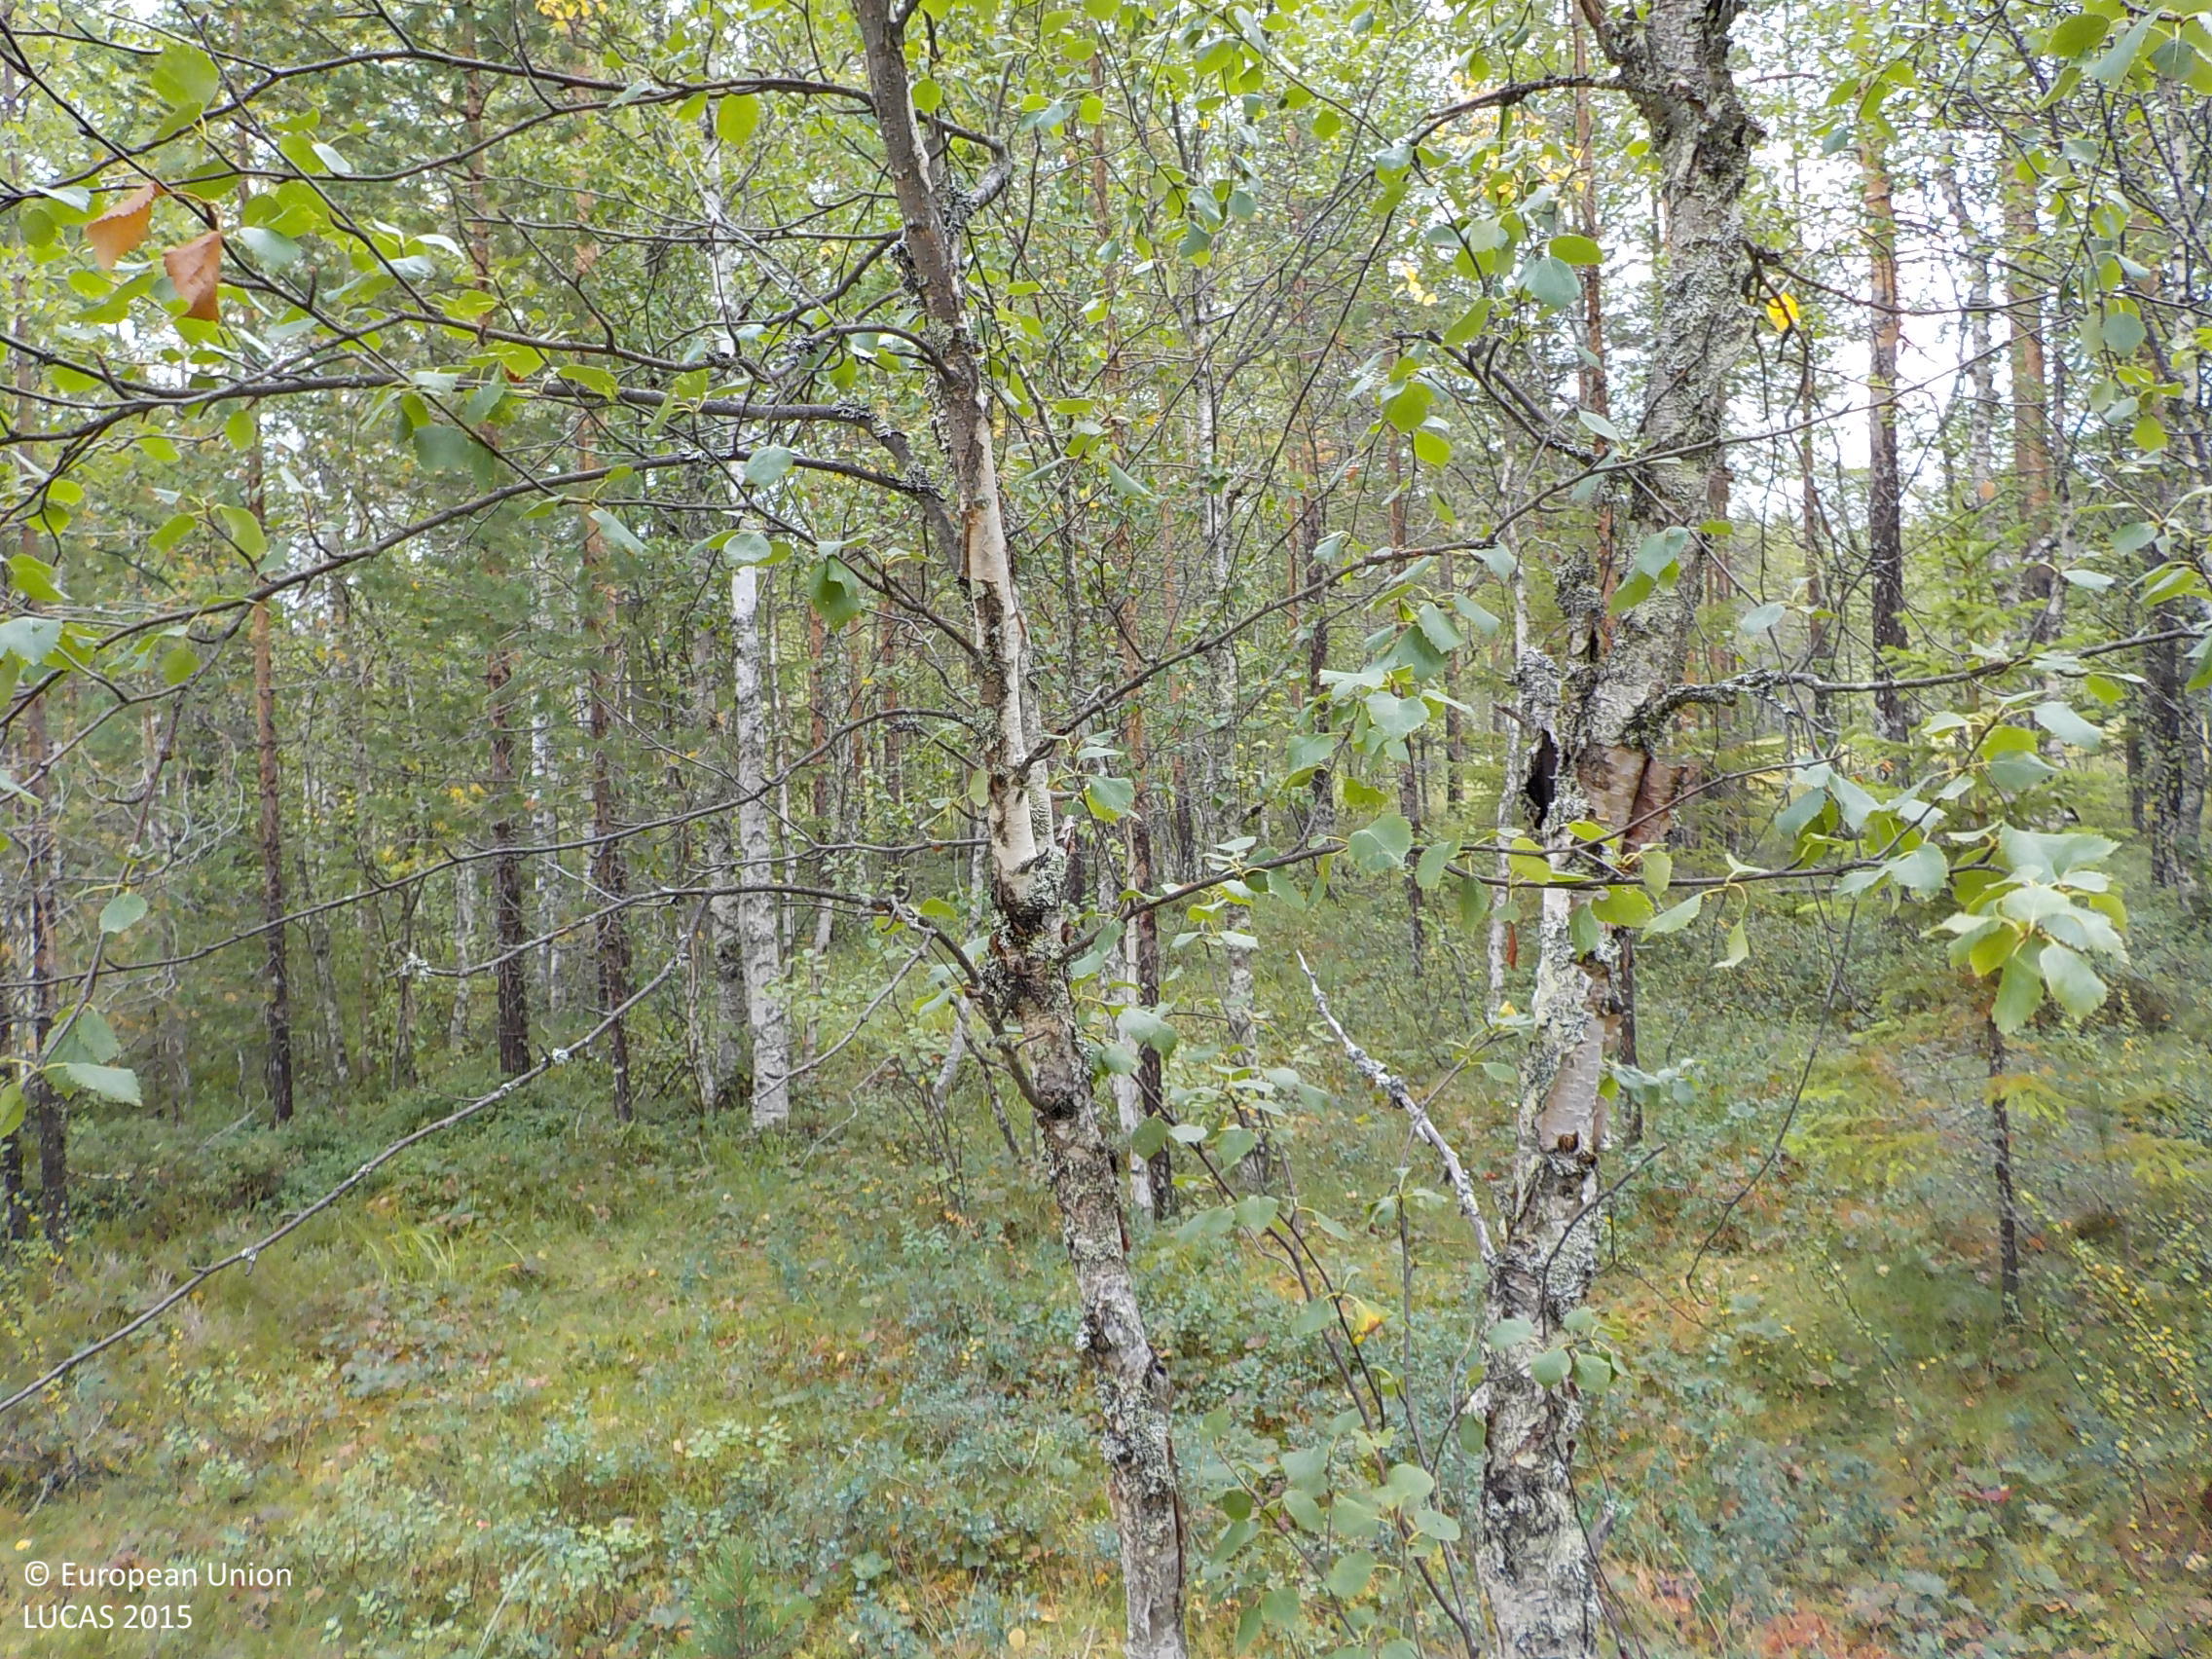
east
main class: Woodland
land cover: Pine dominated mixed woodland
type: boreal forest
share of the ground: 50 - 75 %
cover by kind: coniferous forest trees 40 %, broadleaved forest trees 30 %, lichens and mosses 15 %, shrubs 10 %, herbaceous plants 5 %
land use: Forestry
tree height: > 5 m
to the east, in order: Pine dominated mixed woodland; Ditches and canals; Pine dominated mixed woodland; Pine dominated coniferous woodland; Spruce dominated mixed woodland
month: August
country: SE
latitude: 64.0174
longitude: 17.1923
